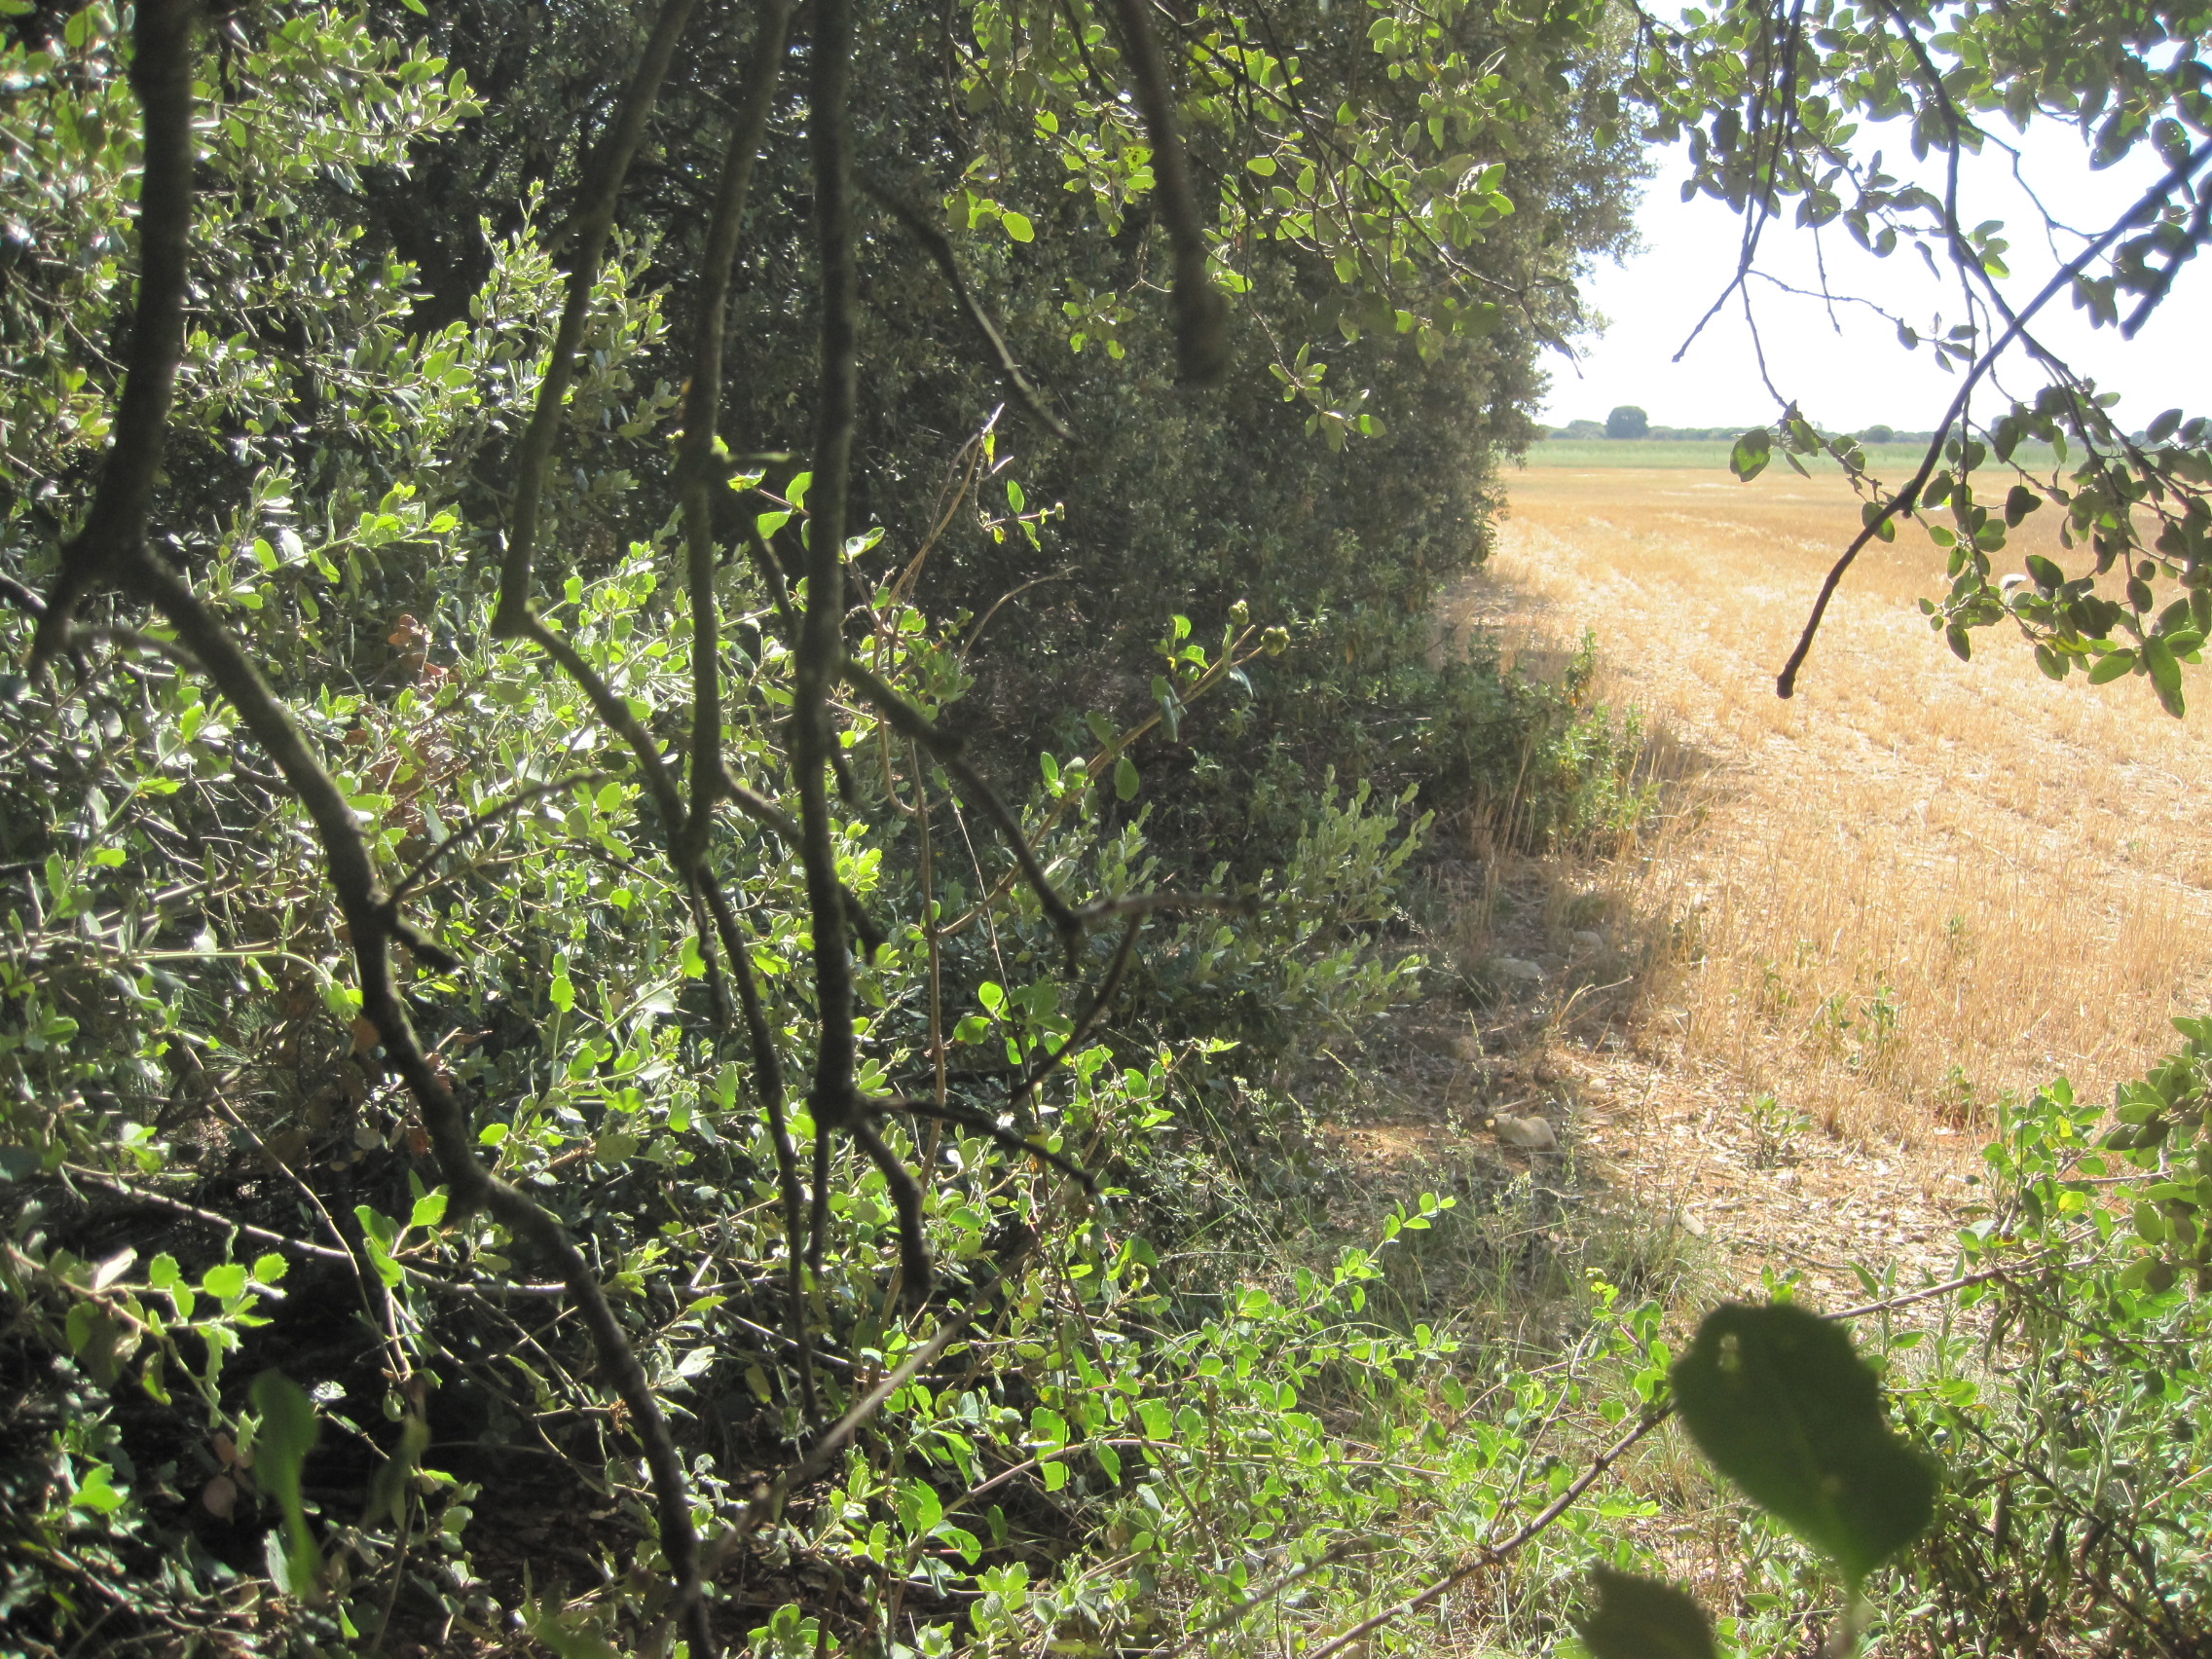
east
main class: Woodland
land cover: Broadleaved woodland
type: thermophilous deciduous forest
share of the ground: > 75 %
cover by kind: broadleaved forest trees 75 %, herbaceous plants 25 %
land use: Forestry
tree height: > 5 m
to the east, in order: Broadleaved woodland; Groves; Barley; Spontaneously vegetated surfaces; Pine dominated coniferous woodland
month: July
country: ES
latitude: 41.8913
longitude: -4.6664
